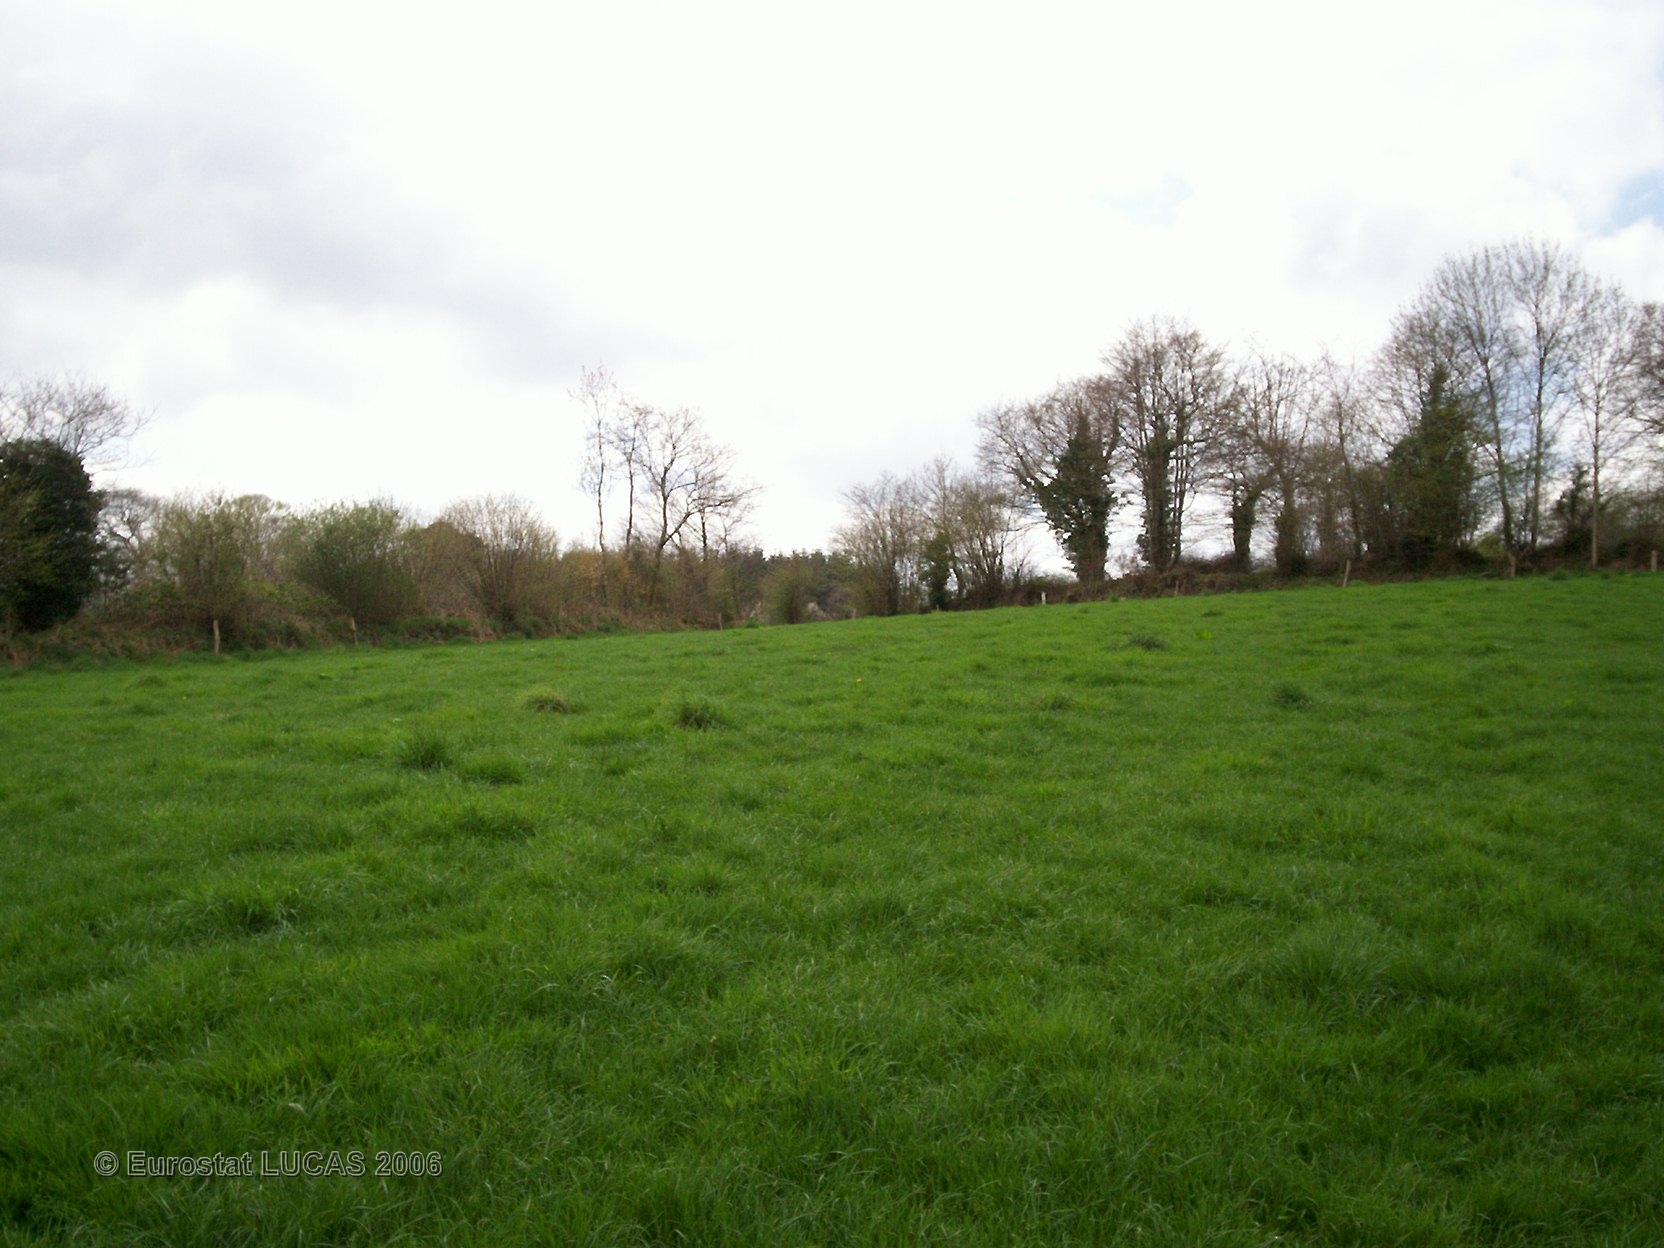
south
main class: Grassland
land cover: Grassland without tree/shrub cover
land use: Agriculture (excluding fallow land and kitchen gardens)
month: April
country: FR
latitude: 48.3742
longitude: -3.7867
